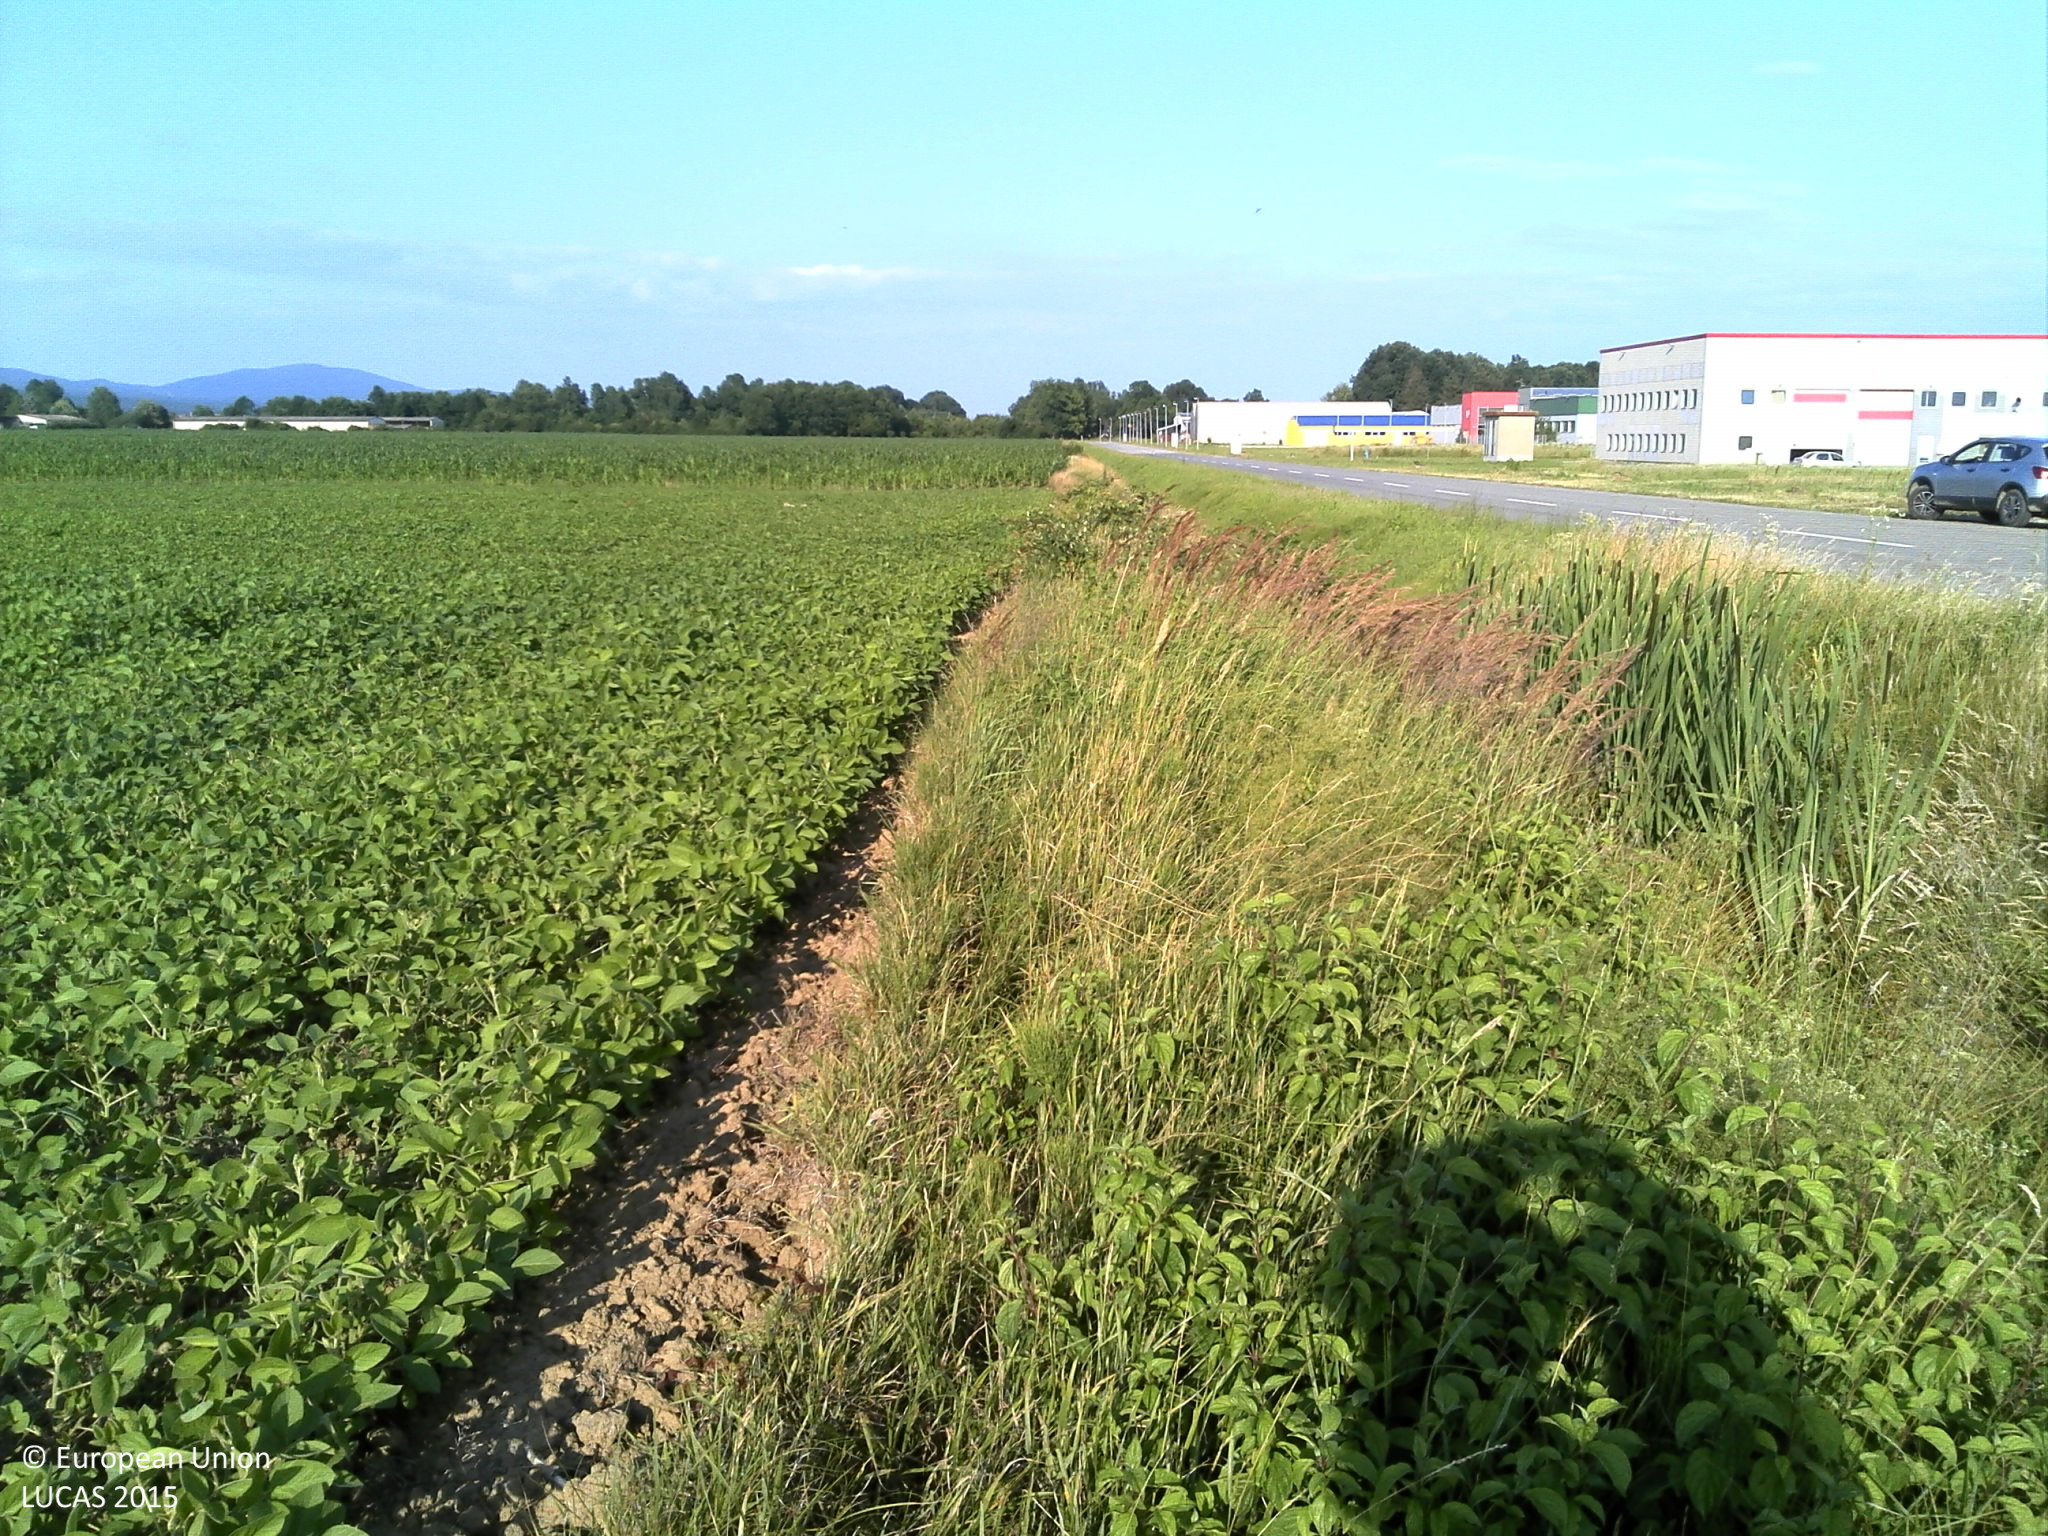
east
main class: Cropland
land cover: Soya
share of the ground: 25 - 50 %
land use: Agriculture (excluding fallow land and kitchen gardens)
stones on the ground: < 10 %
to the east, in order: Soya; Paved roads, cycling and walking lanes
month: June
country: HR
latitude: 45.2282
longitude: 17.3744
